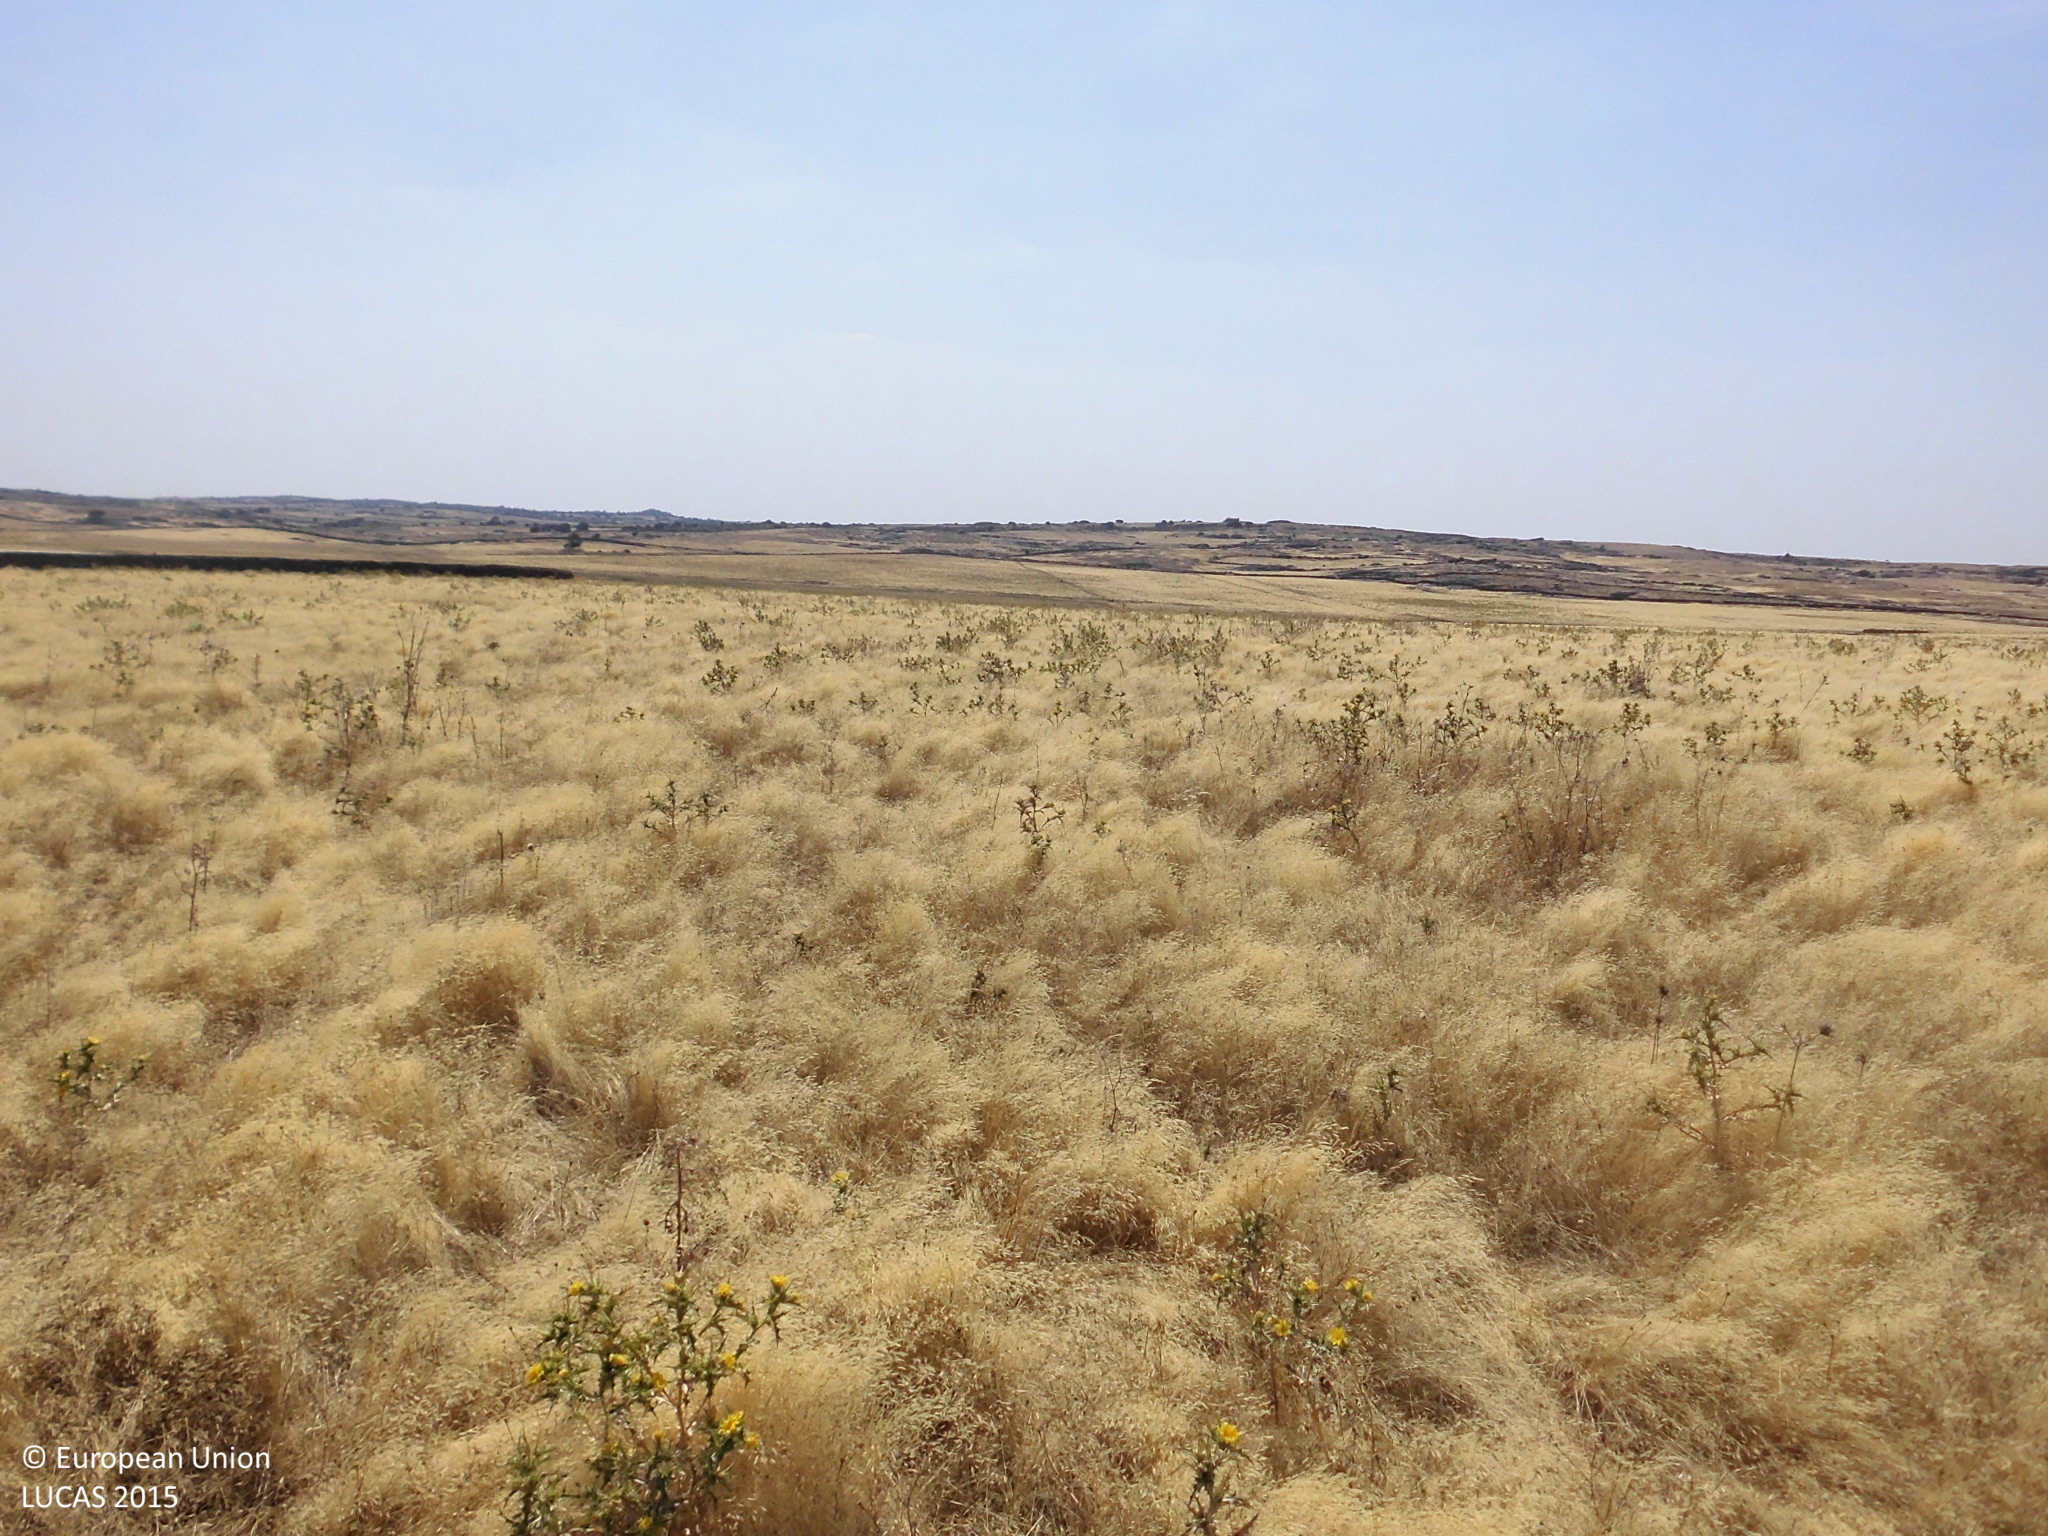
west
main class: Grassland
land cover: Grassland without tree/shrub cover
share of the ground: > 75 %
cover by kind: herbaceous plants 100 %
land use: Agriculture (excluding fallow land and kitchen gardens)
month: June
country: ES
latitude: 39.4733
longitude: -5.8082
